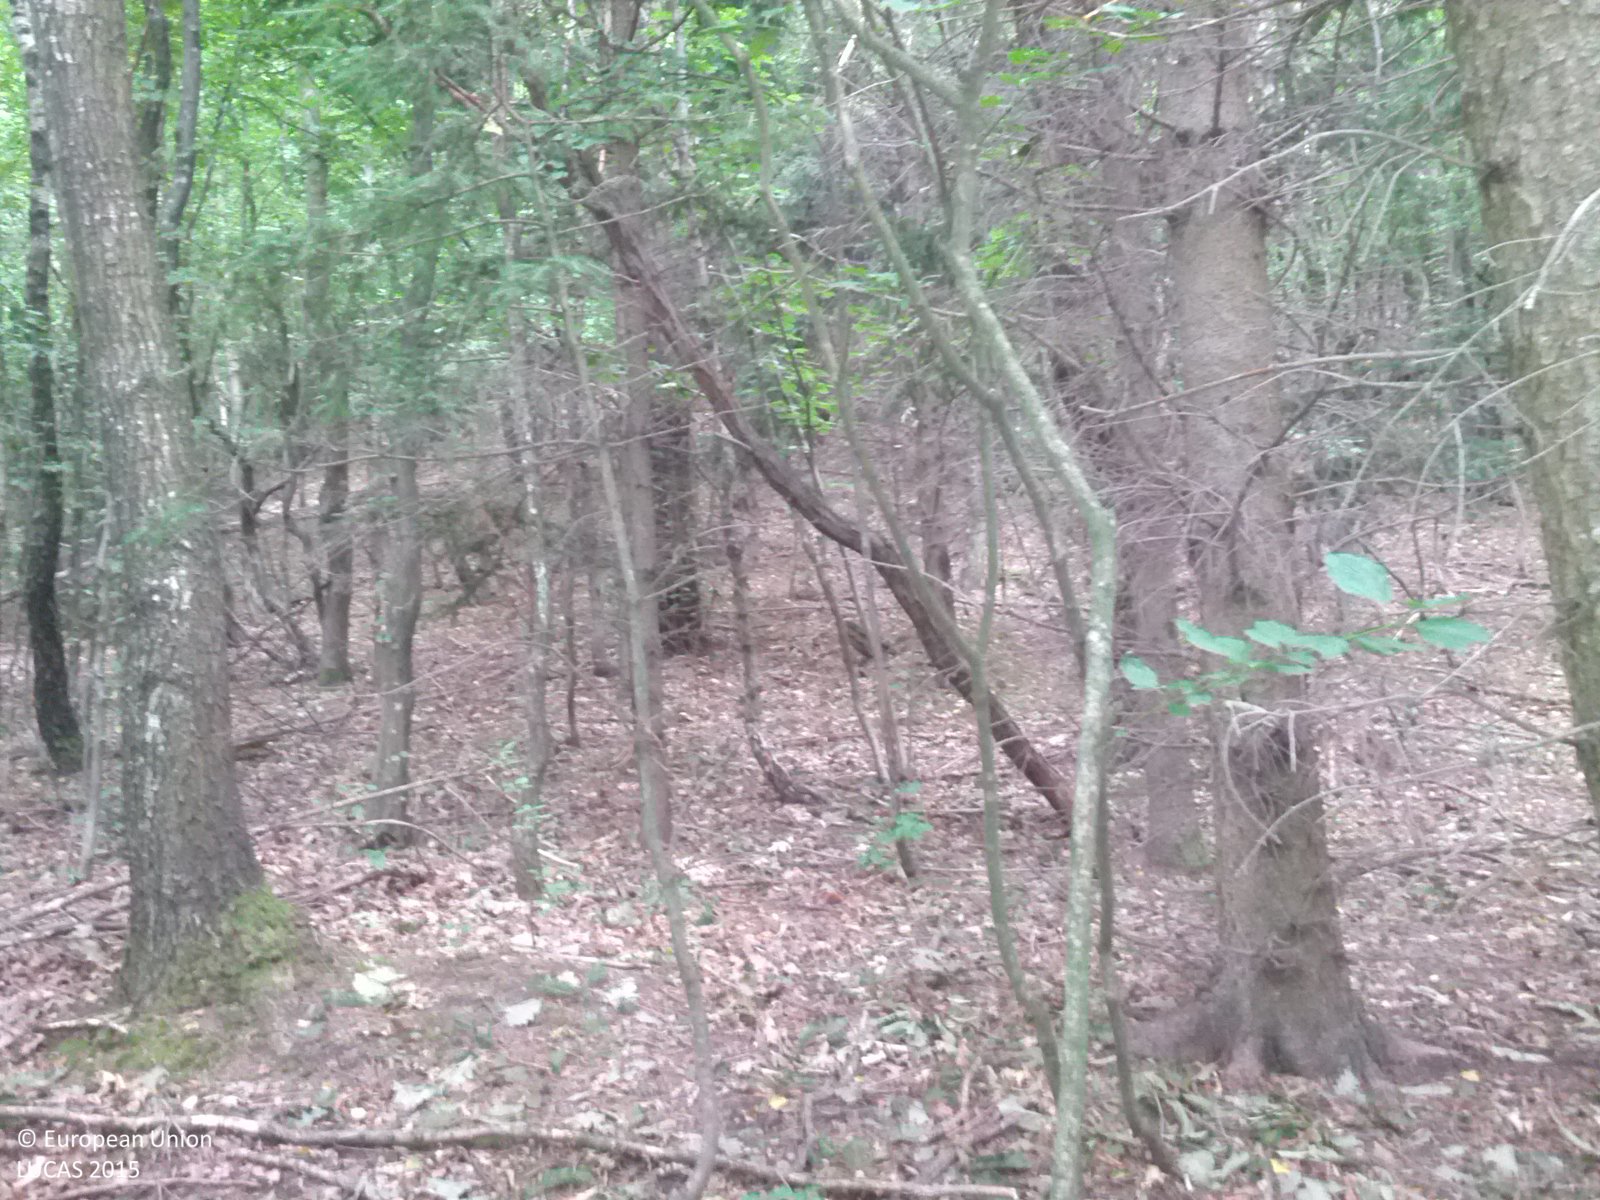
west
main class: Woodland
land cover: Spruce dominated mixed woodland
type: alpine coniferous forest
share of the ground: > 75 %
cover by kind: coniferous forest trees 55 %, broadleaved forest trees 35 %, shrubs 5 %, unconsolidated bare surface 5 %
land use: Forestry
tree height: > 5 m
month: July
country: AT
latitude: 47.3143
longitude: 16.4190
